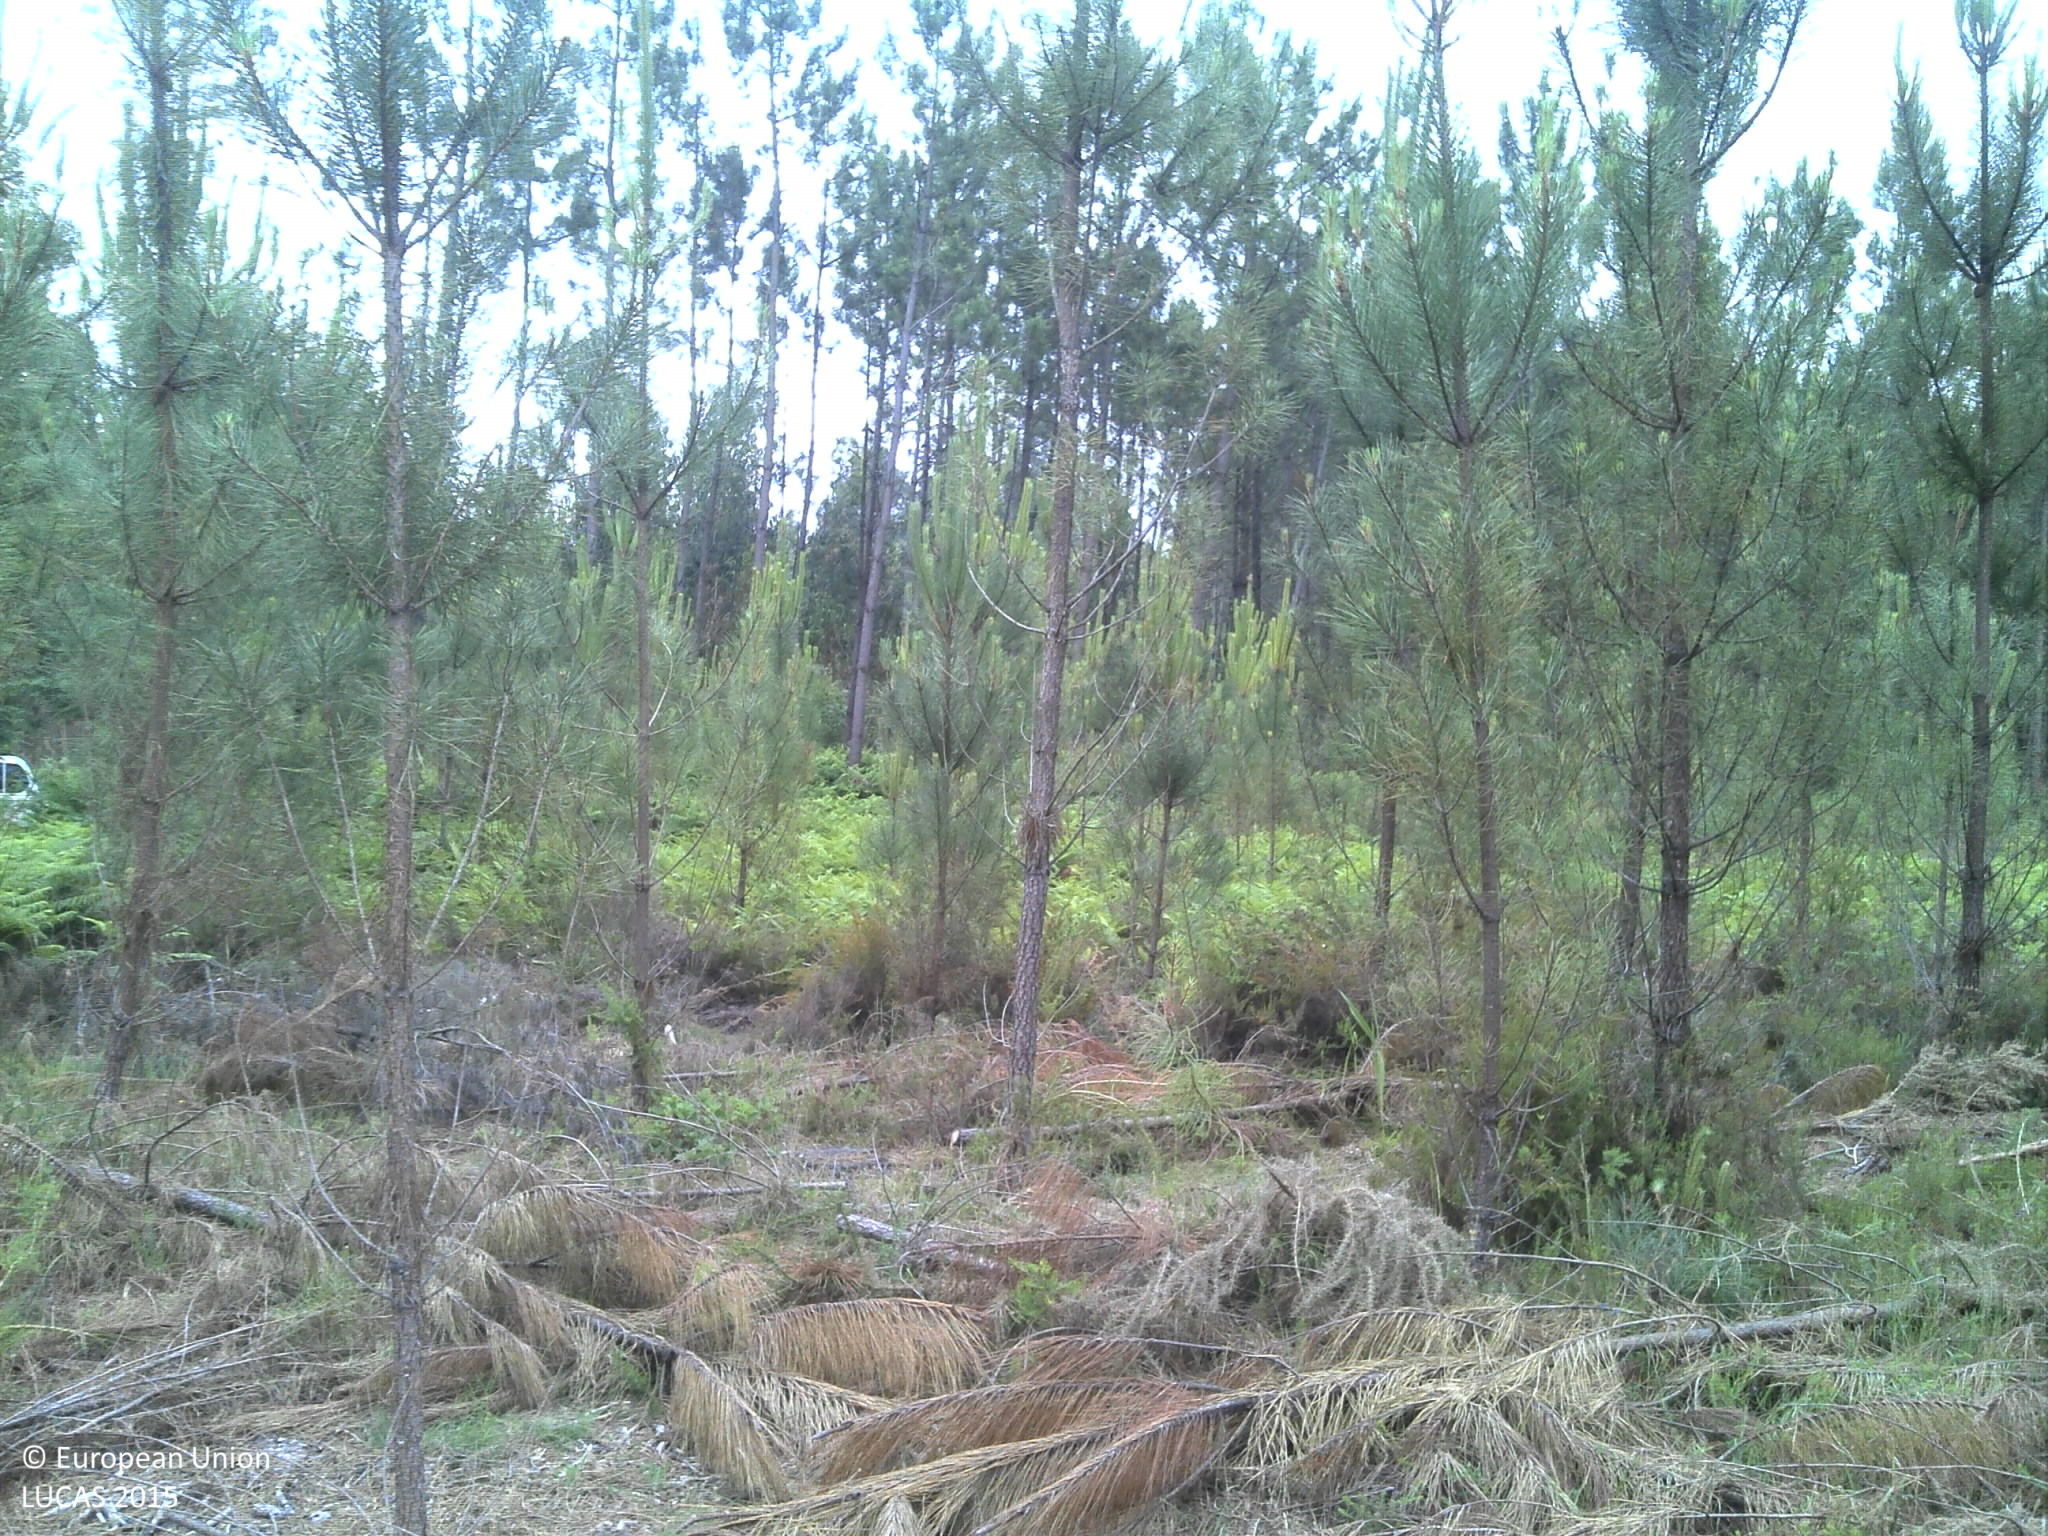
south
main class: Woodland
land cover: Pine dominated coniferous woodland
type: coniferous forest of the mediterranean region
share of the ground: 10 - 25 %
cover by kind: coniferous forest trees 25 %, shrubs 25 %, unconsolidated bare surface 5 %
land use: Forestry
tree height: < 5 m
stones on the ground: < 10 %
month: June
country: PT
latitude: 40.3777
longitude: -8.5952
